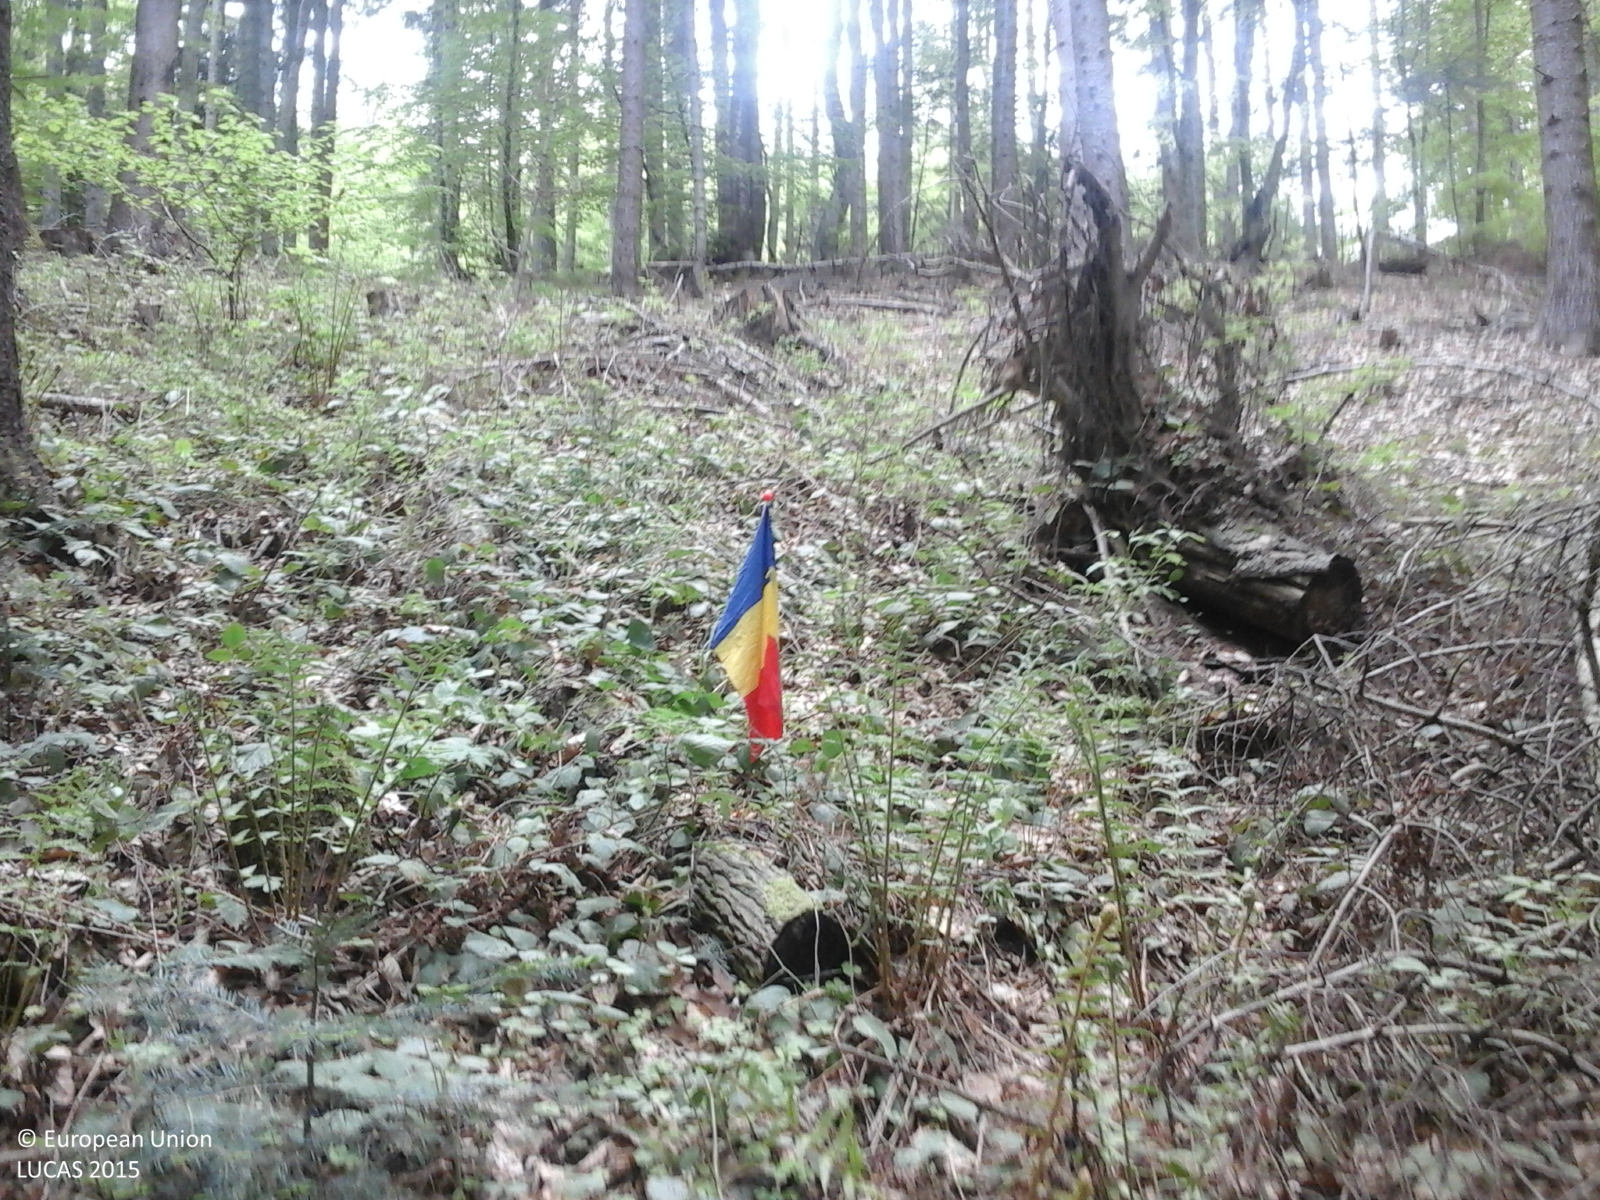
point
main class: Woodland
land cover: Spruce dominated mixed woodland
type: alpine coniferous forest
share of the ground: > 75 %
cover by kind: coniferous forest trees 75 %, broadleaved forest trees 25 %
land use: Forestry
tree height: > 5 m
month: May
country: RO
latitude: 45.9857
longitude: 26.3262
